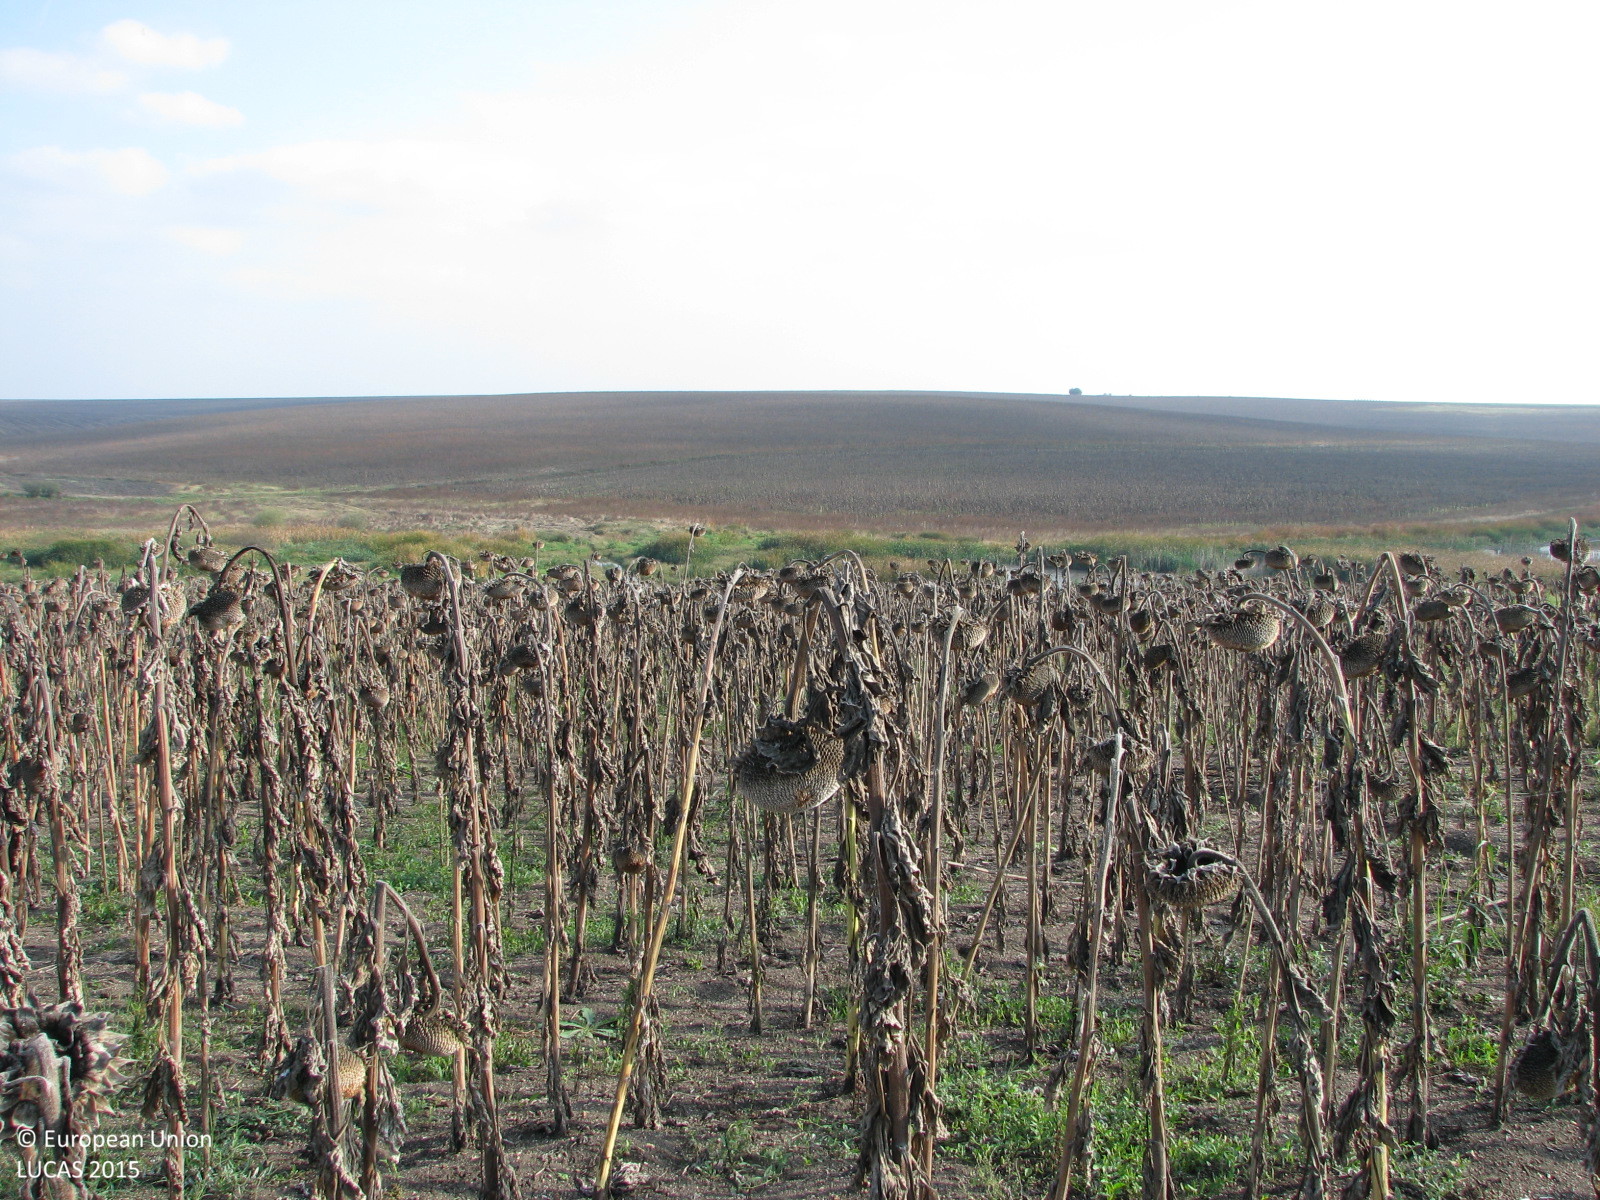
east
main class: Cropland
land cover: Sunflower
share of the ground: > 75 %
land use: Agriculture (excluding fallow land and kitchen gardens)
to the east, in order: Sunflower; Spontaneously vegetated surfaces; Sunflower
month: October
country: BG
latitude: 42.3481
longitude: 26.4404
